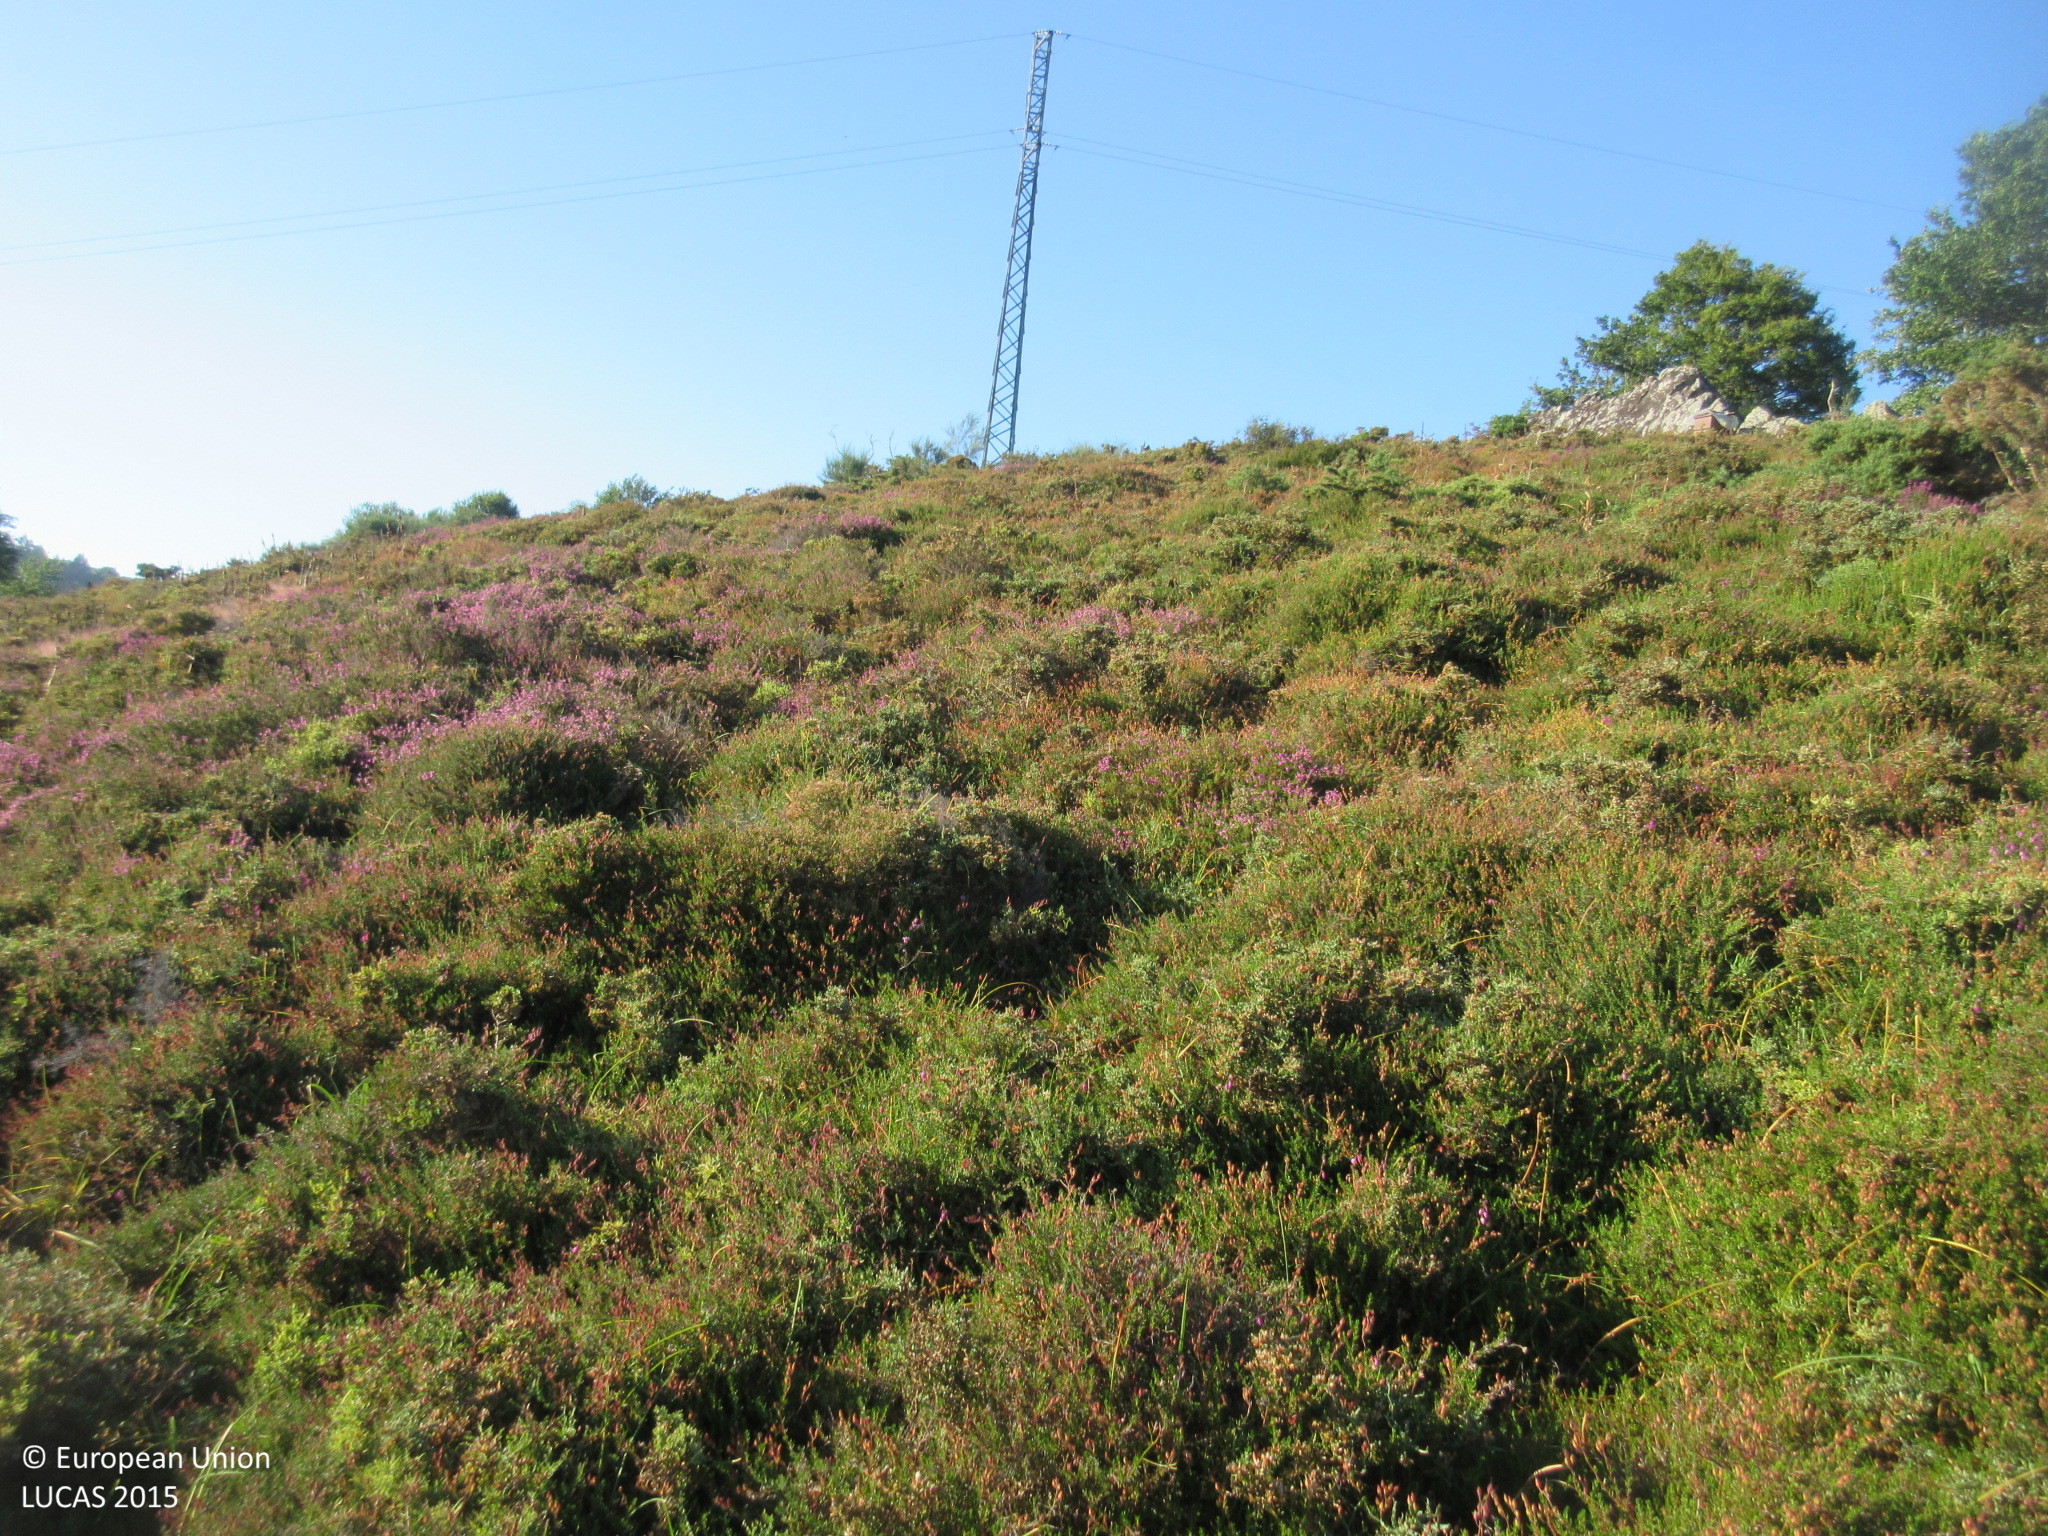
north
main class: Woodland
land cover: Broadleaved woodland
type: acidophilous oak and oak-birch forest
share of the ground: 50 - 75 %
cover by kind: broadleaved forest trees 70 %, shrubs 30 %
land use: Forestry
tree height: > 5 m
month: June
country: ES
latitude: 43.0121
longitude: -6.9809
